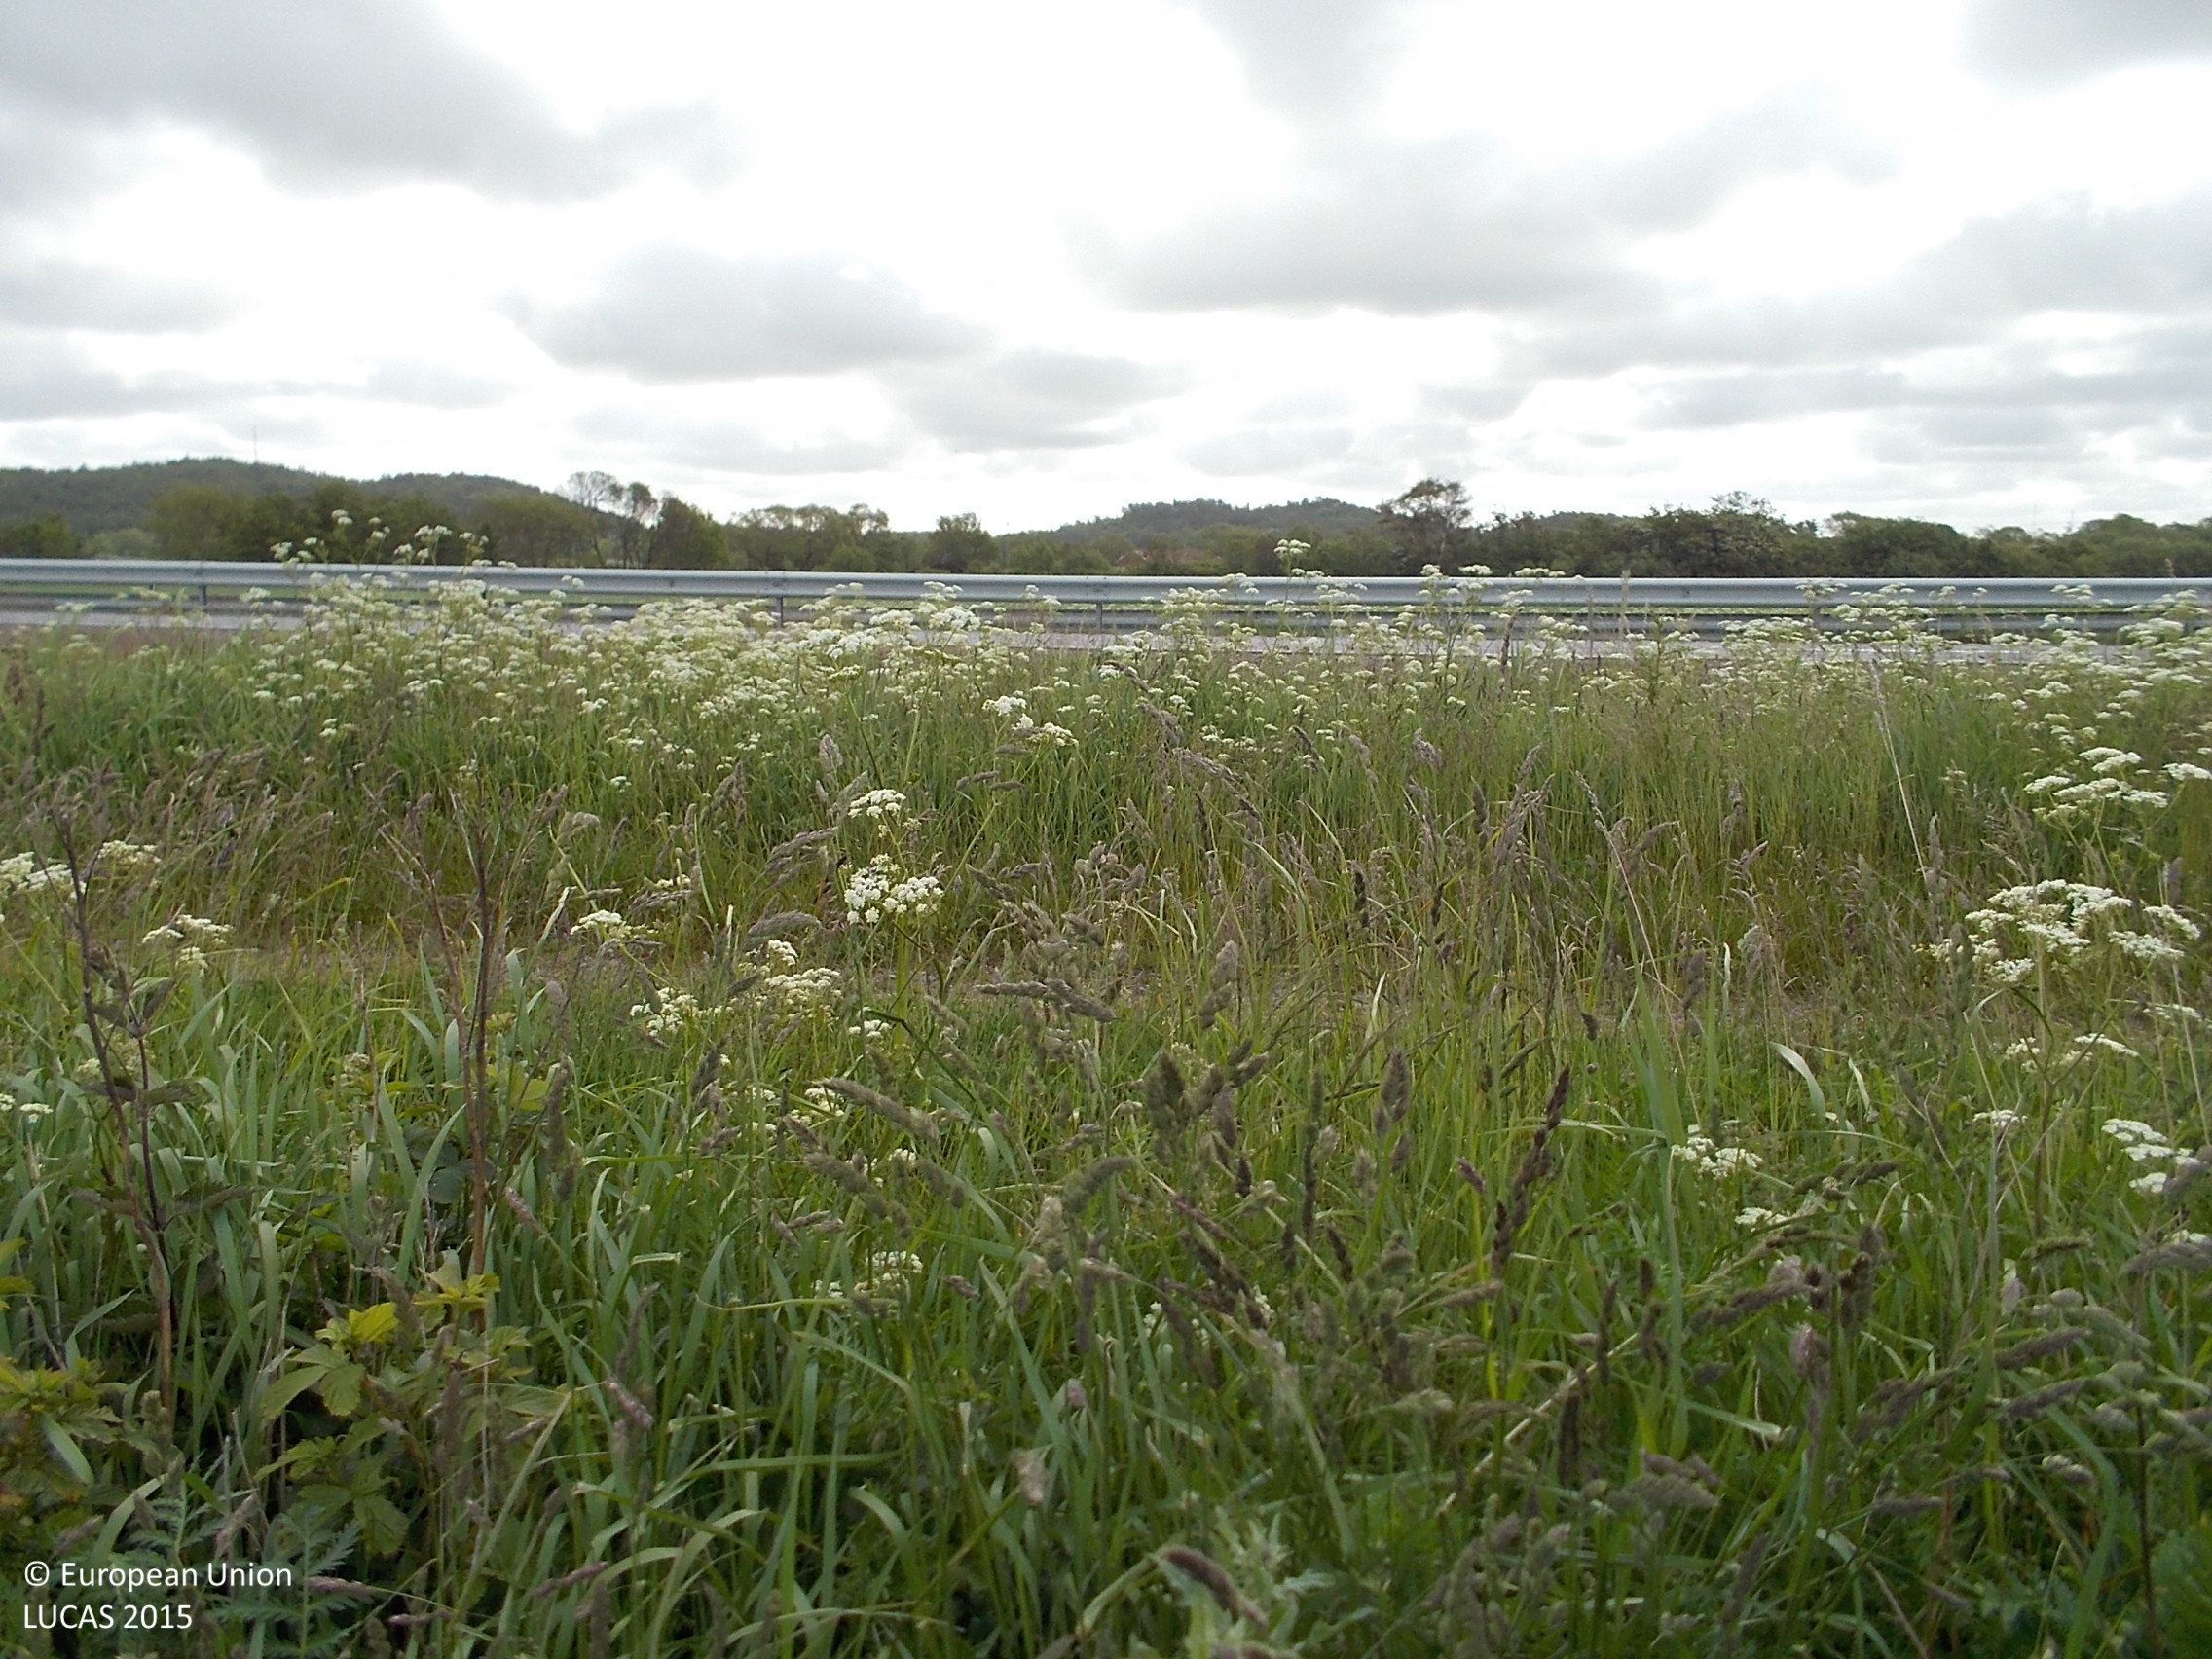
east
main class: Cropland
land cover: Common wheat
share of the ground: > 75 %
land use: Agriculture (excluding fallow land and kitchen gardens)
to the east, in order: Common wheat; Shruby margins; Tracks; Spontaneously vegetated surfaces; Paved roads, cycling and walking lanes; Spontaneously vegetated surfaces; Paved roads, cycling and walking lanes; Shruby margins; Common wheat
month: June
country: SE
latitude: 57.1391
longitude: 12.2607
